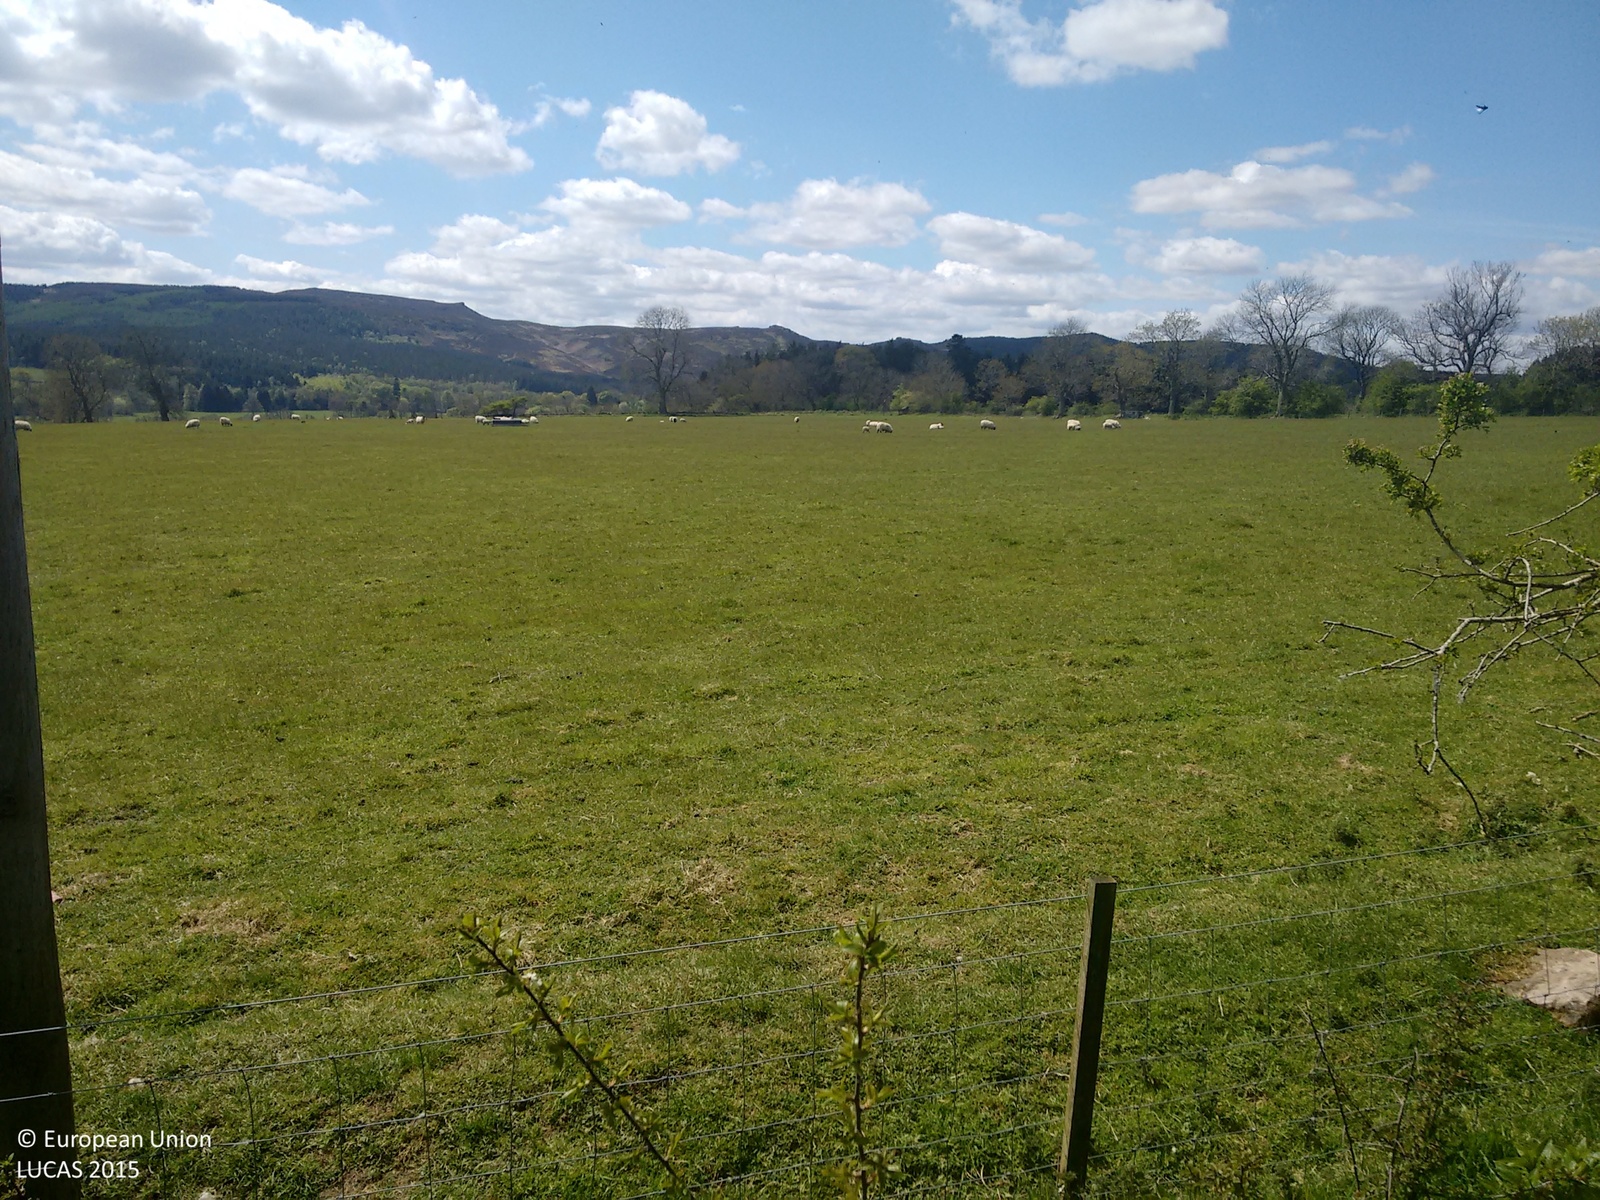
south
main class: Woodland
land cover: Broadleaved woodland
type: acidophilous oak and oak-birch forest
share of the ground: > 75 %
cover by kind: broadleaved forest trees 100 %
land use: Agriculture (excluding fallow land and kitchen gardens)
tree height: > 5 m
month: May
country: GB
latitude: 55.3410
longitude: -2.0852
